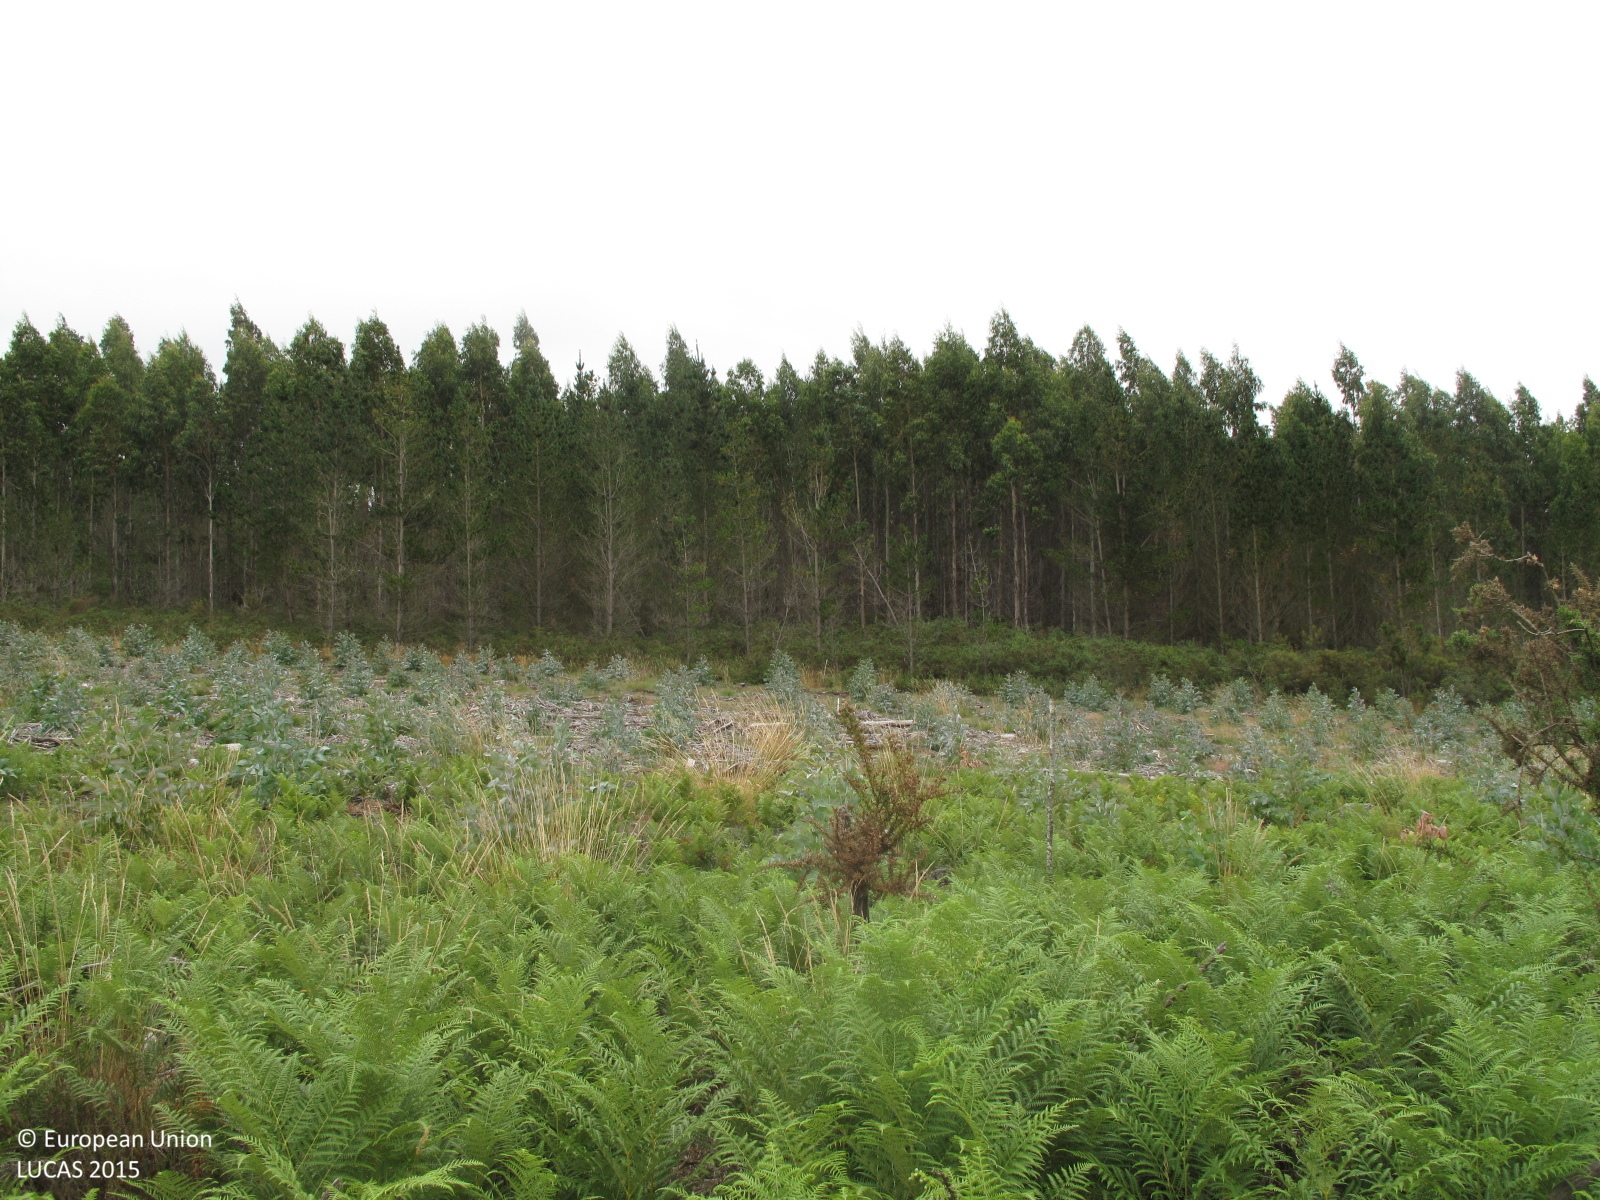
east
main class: Shrubland
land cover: Shrubland with sparse tree cover
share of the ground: 10 - 25 %
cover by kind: herbaceous plants 70 %, shrubs 15 %, lichens and mosses 10 %, broadleaved forest trees 5 %
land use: Abandoned areas
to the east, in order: Shrubland with sparse tree cover; Broadleaved woodland; Pine dominated coniferous woodland; Shrubland without tree cover; Spruce dominated mixed woodland
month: July
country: ES
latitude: 43.1683
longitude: -7.9887
